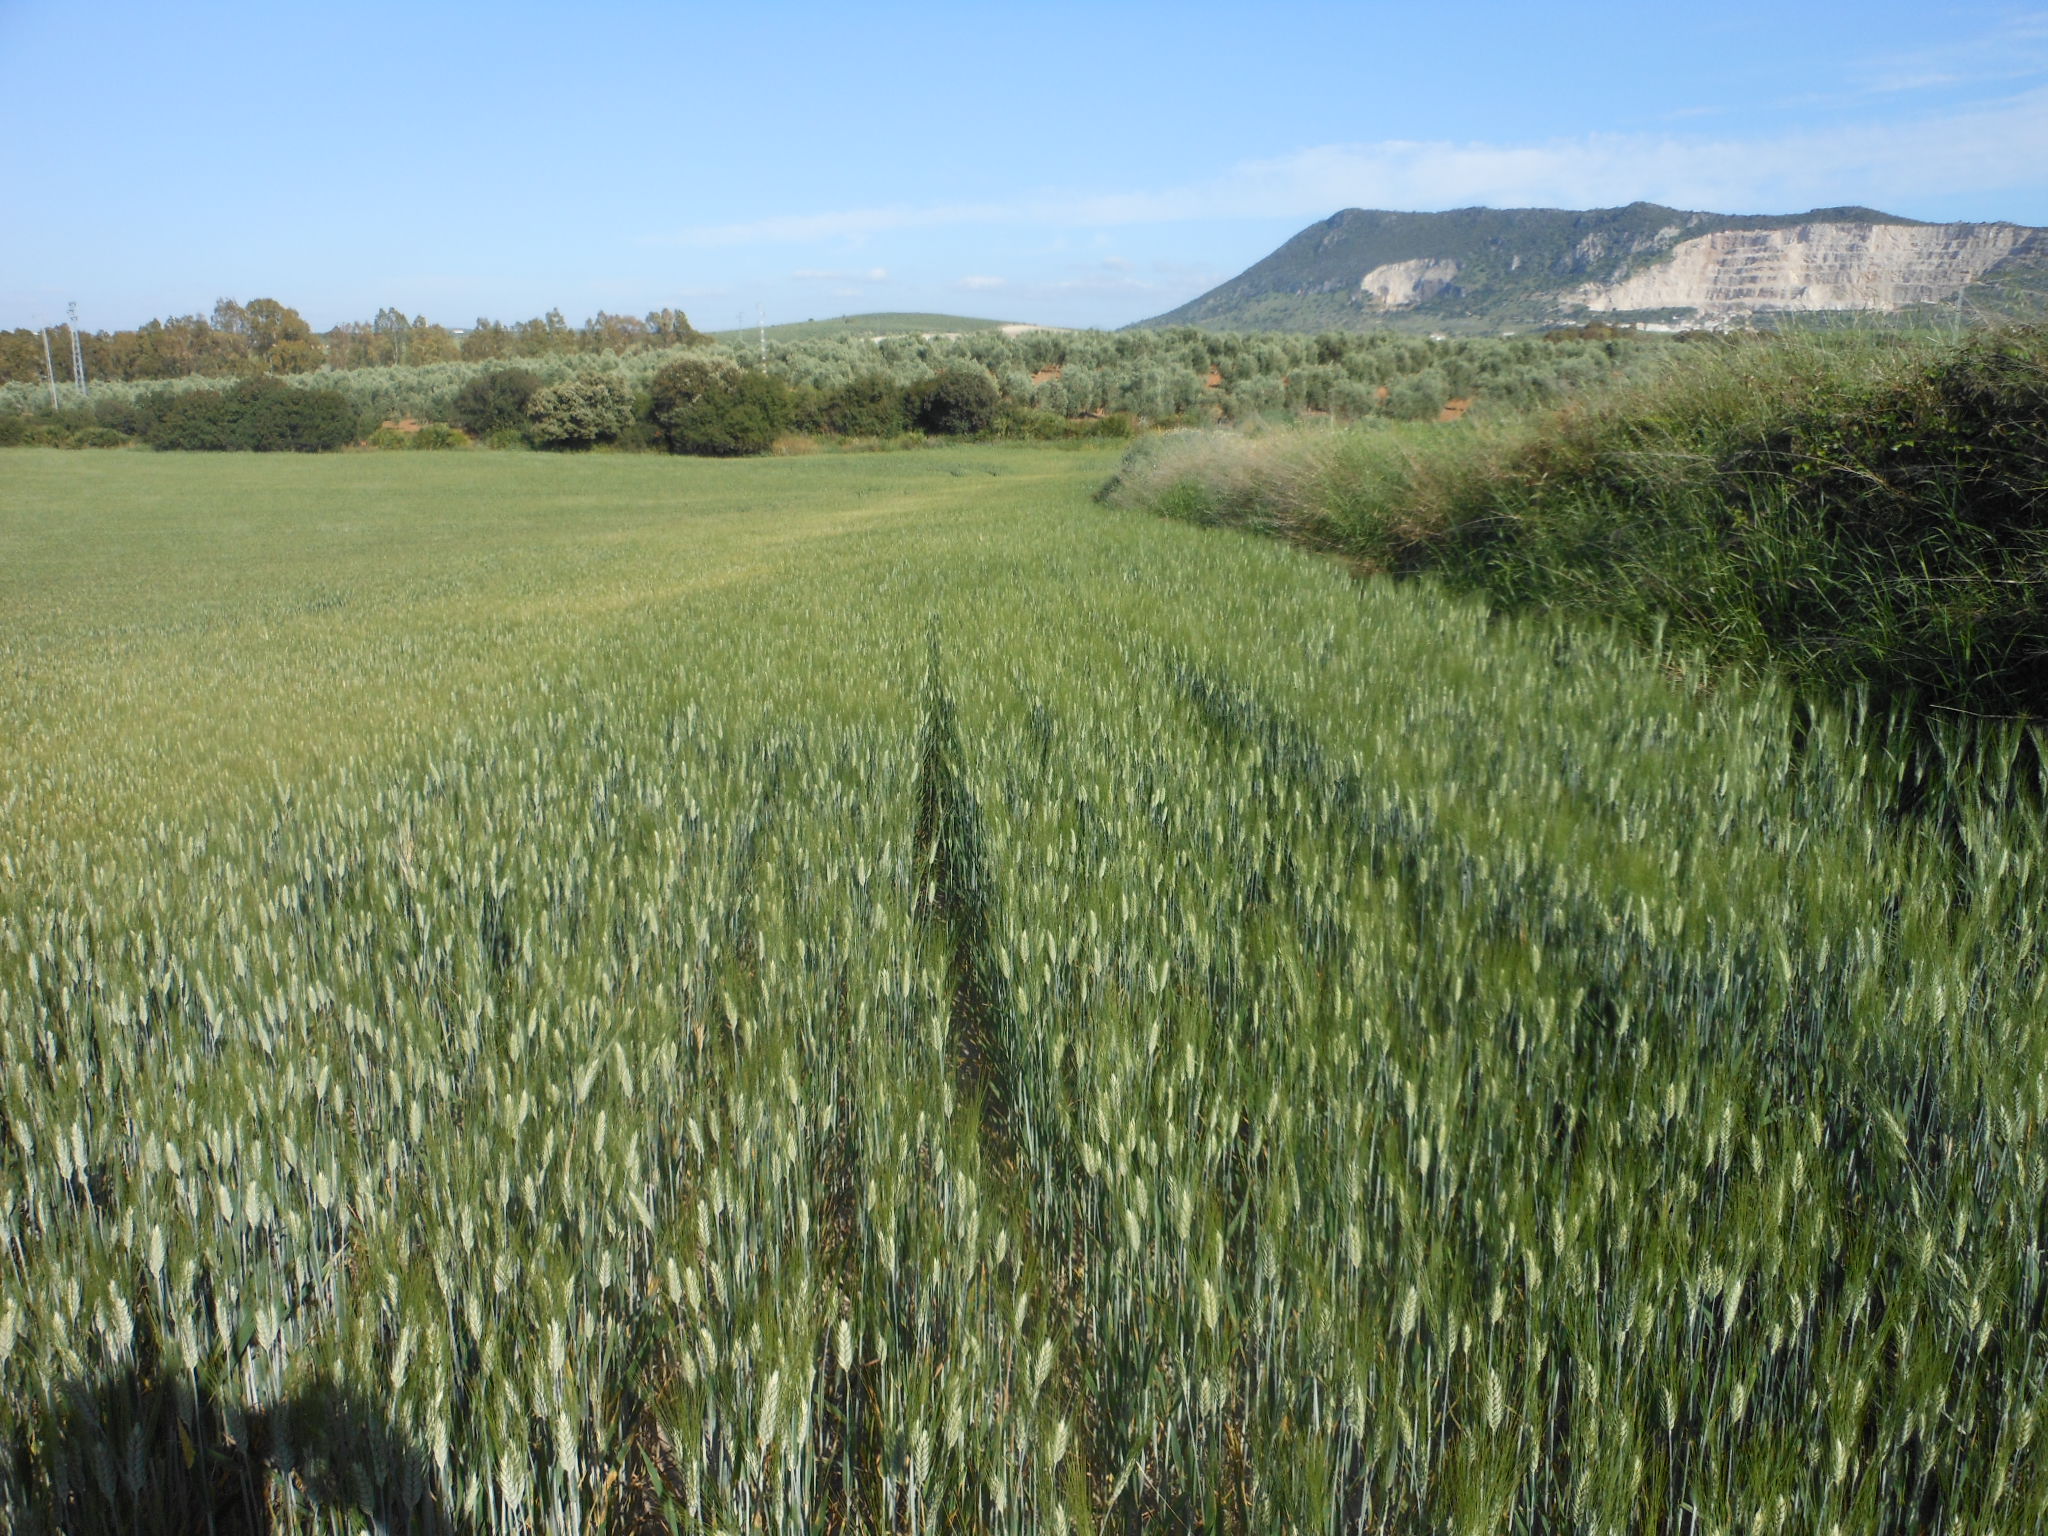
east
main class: Cropland
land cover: Durum wheat
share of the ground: > 75 %
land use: Agriculture (excluding fallow land and kitchen gardens)
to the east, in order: Durum wheat; Grass margins; Fences; Shrubland without tree cover; Tracks; Fences; Olive groves; Electric lines; Olive groves
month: April
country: ES
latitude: 37.1083
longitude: -5.5290
